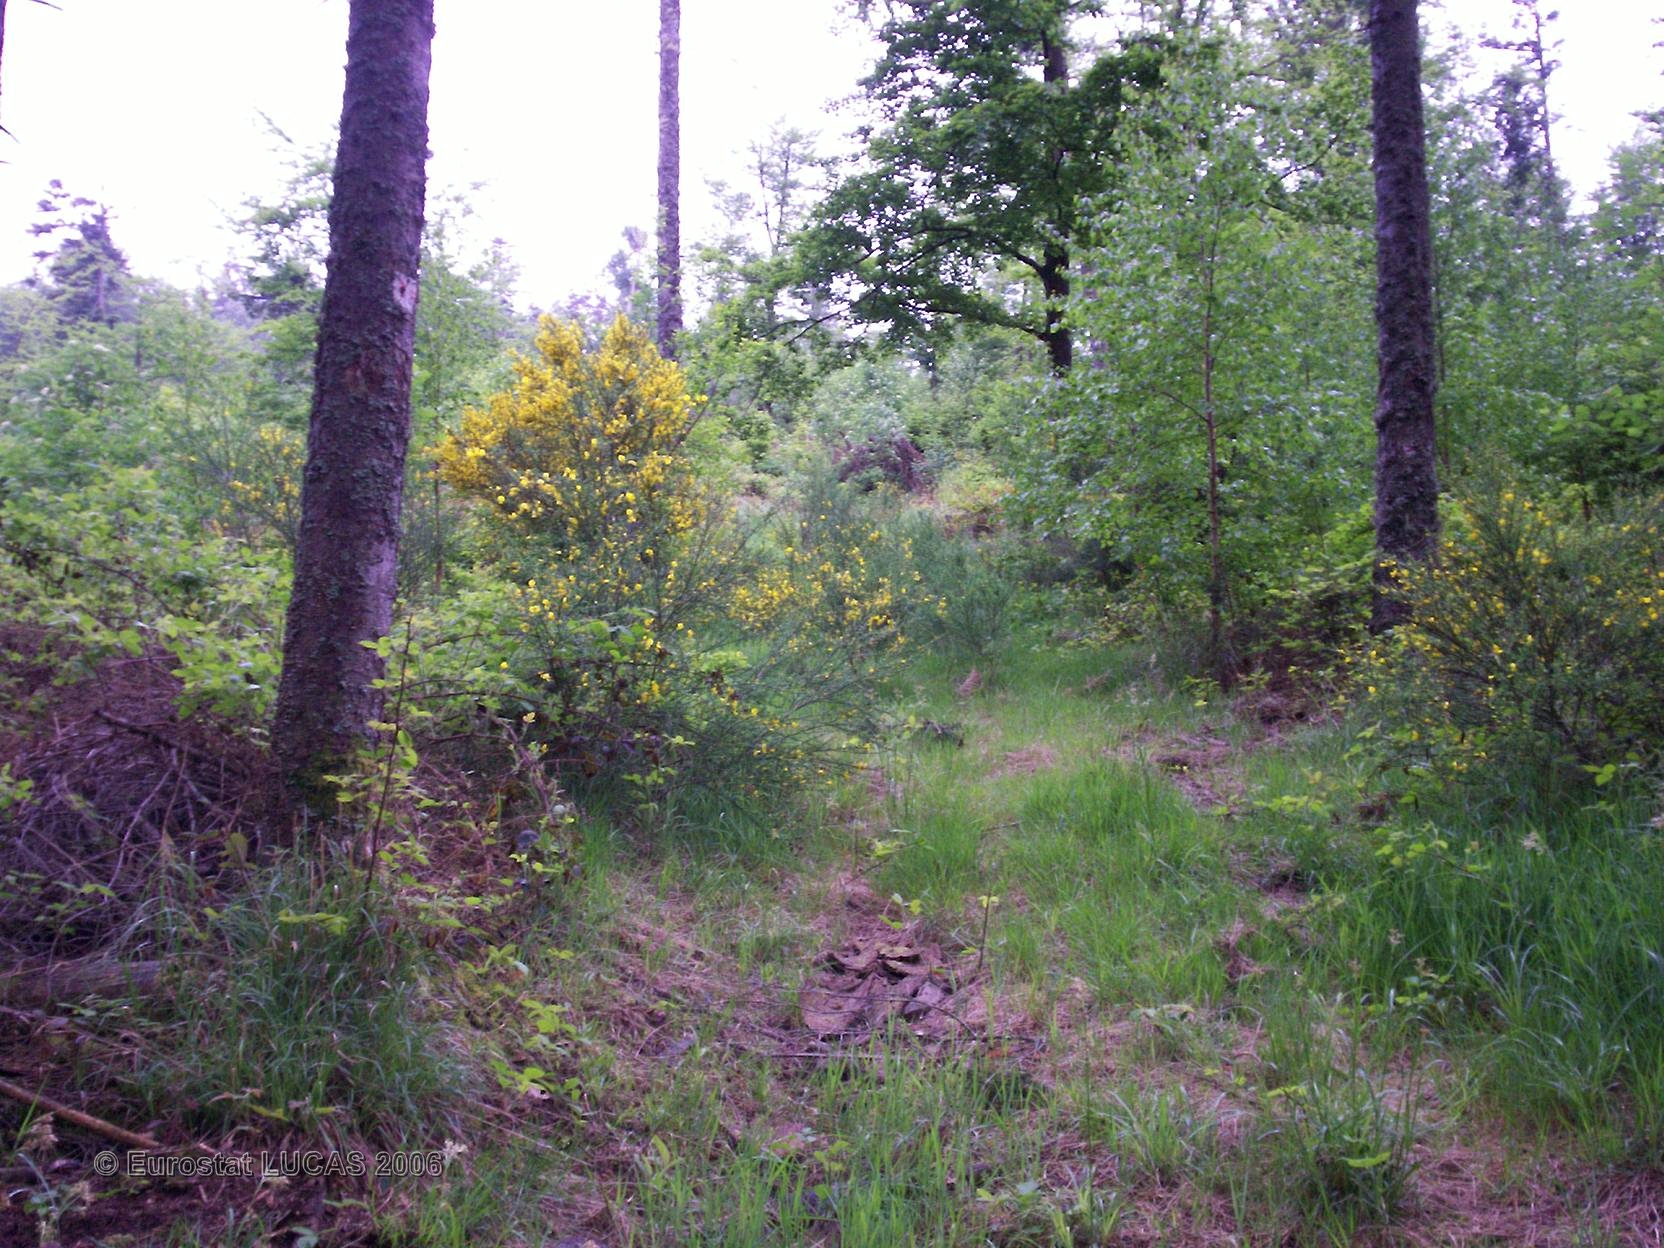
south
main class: Woodland
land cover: Mixed forest
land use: Forestry
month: May
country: FR
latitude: 48.1588
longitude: 6.7879
